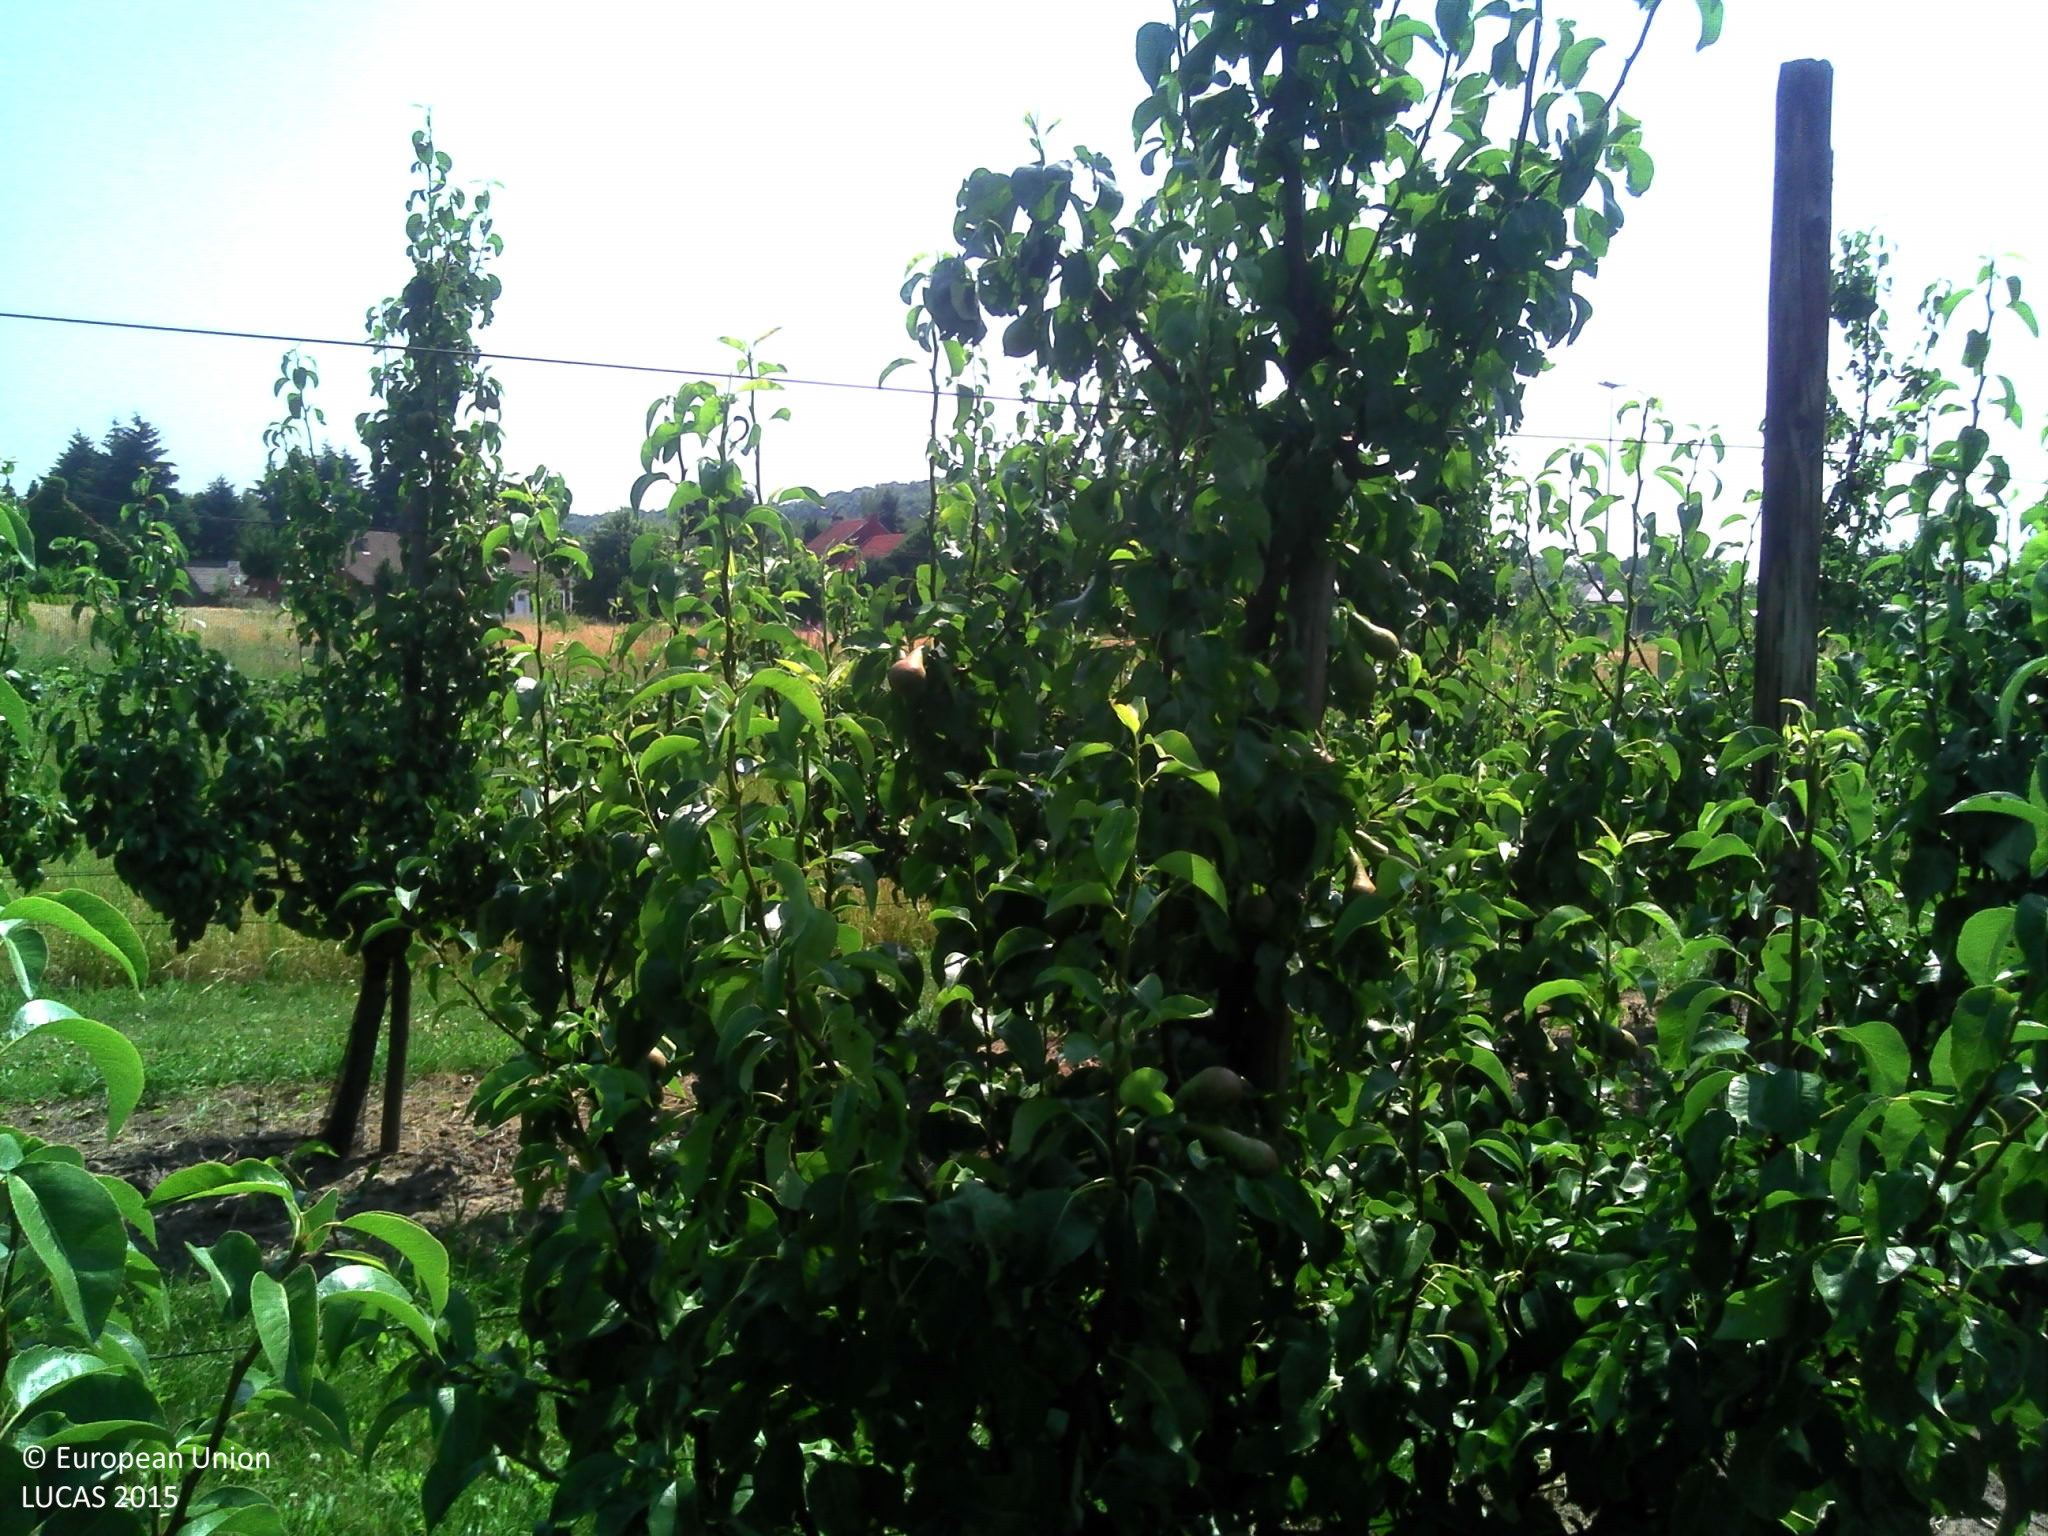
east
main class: Cropland
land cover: Pear fruit
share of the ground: > 75 %
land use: Agriculture (excluding fallow land and kitchen gardens)
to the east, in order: Pear fruit; Grassland without tree/shrub cover; Strawberries; Grassland without tree/shrub cover; Barley; Potatoes; Artificial constructions in urban areas; Maize
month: July
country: BE
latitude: 50.9473
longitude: 4.7728
